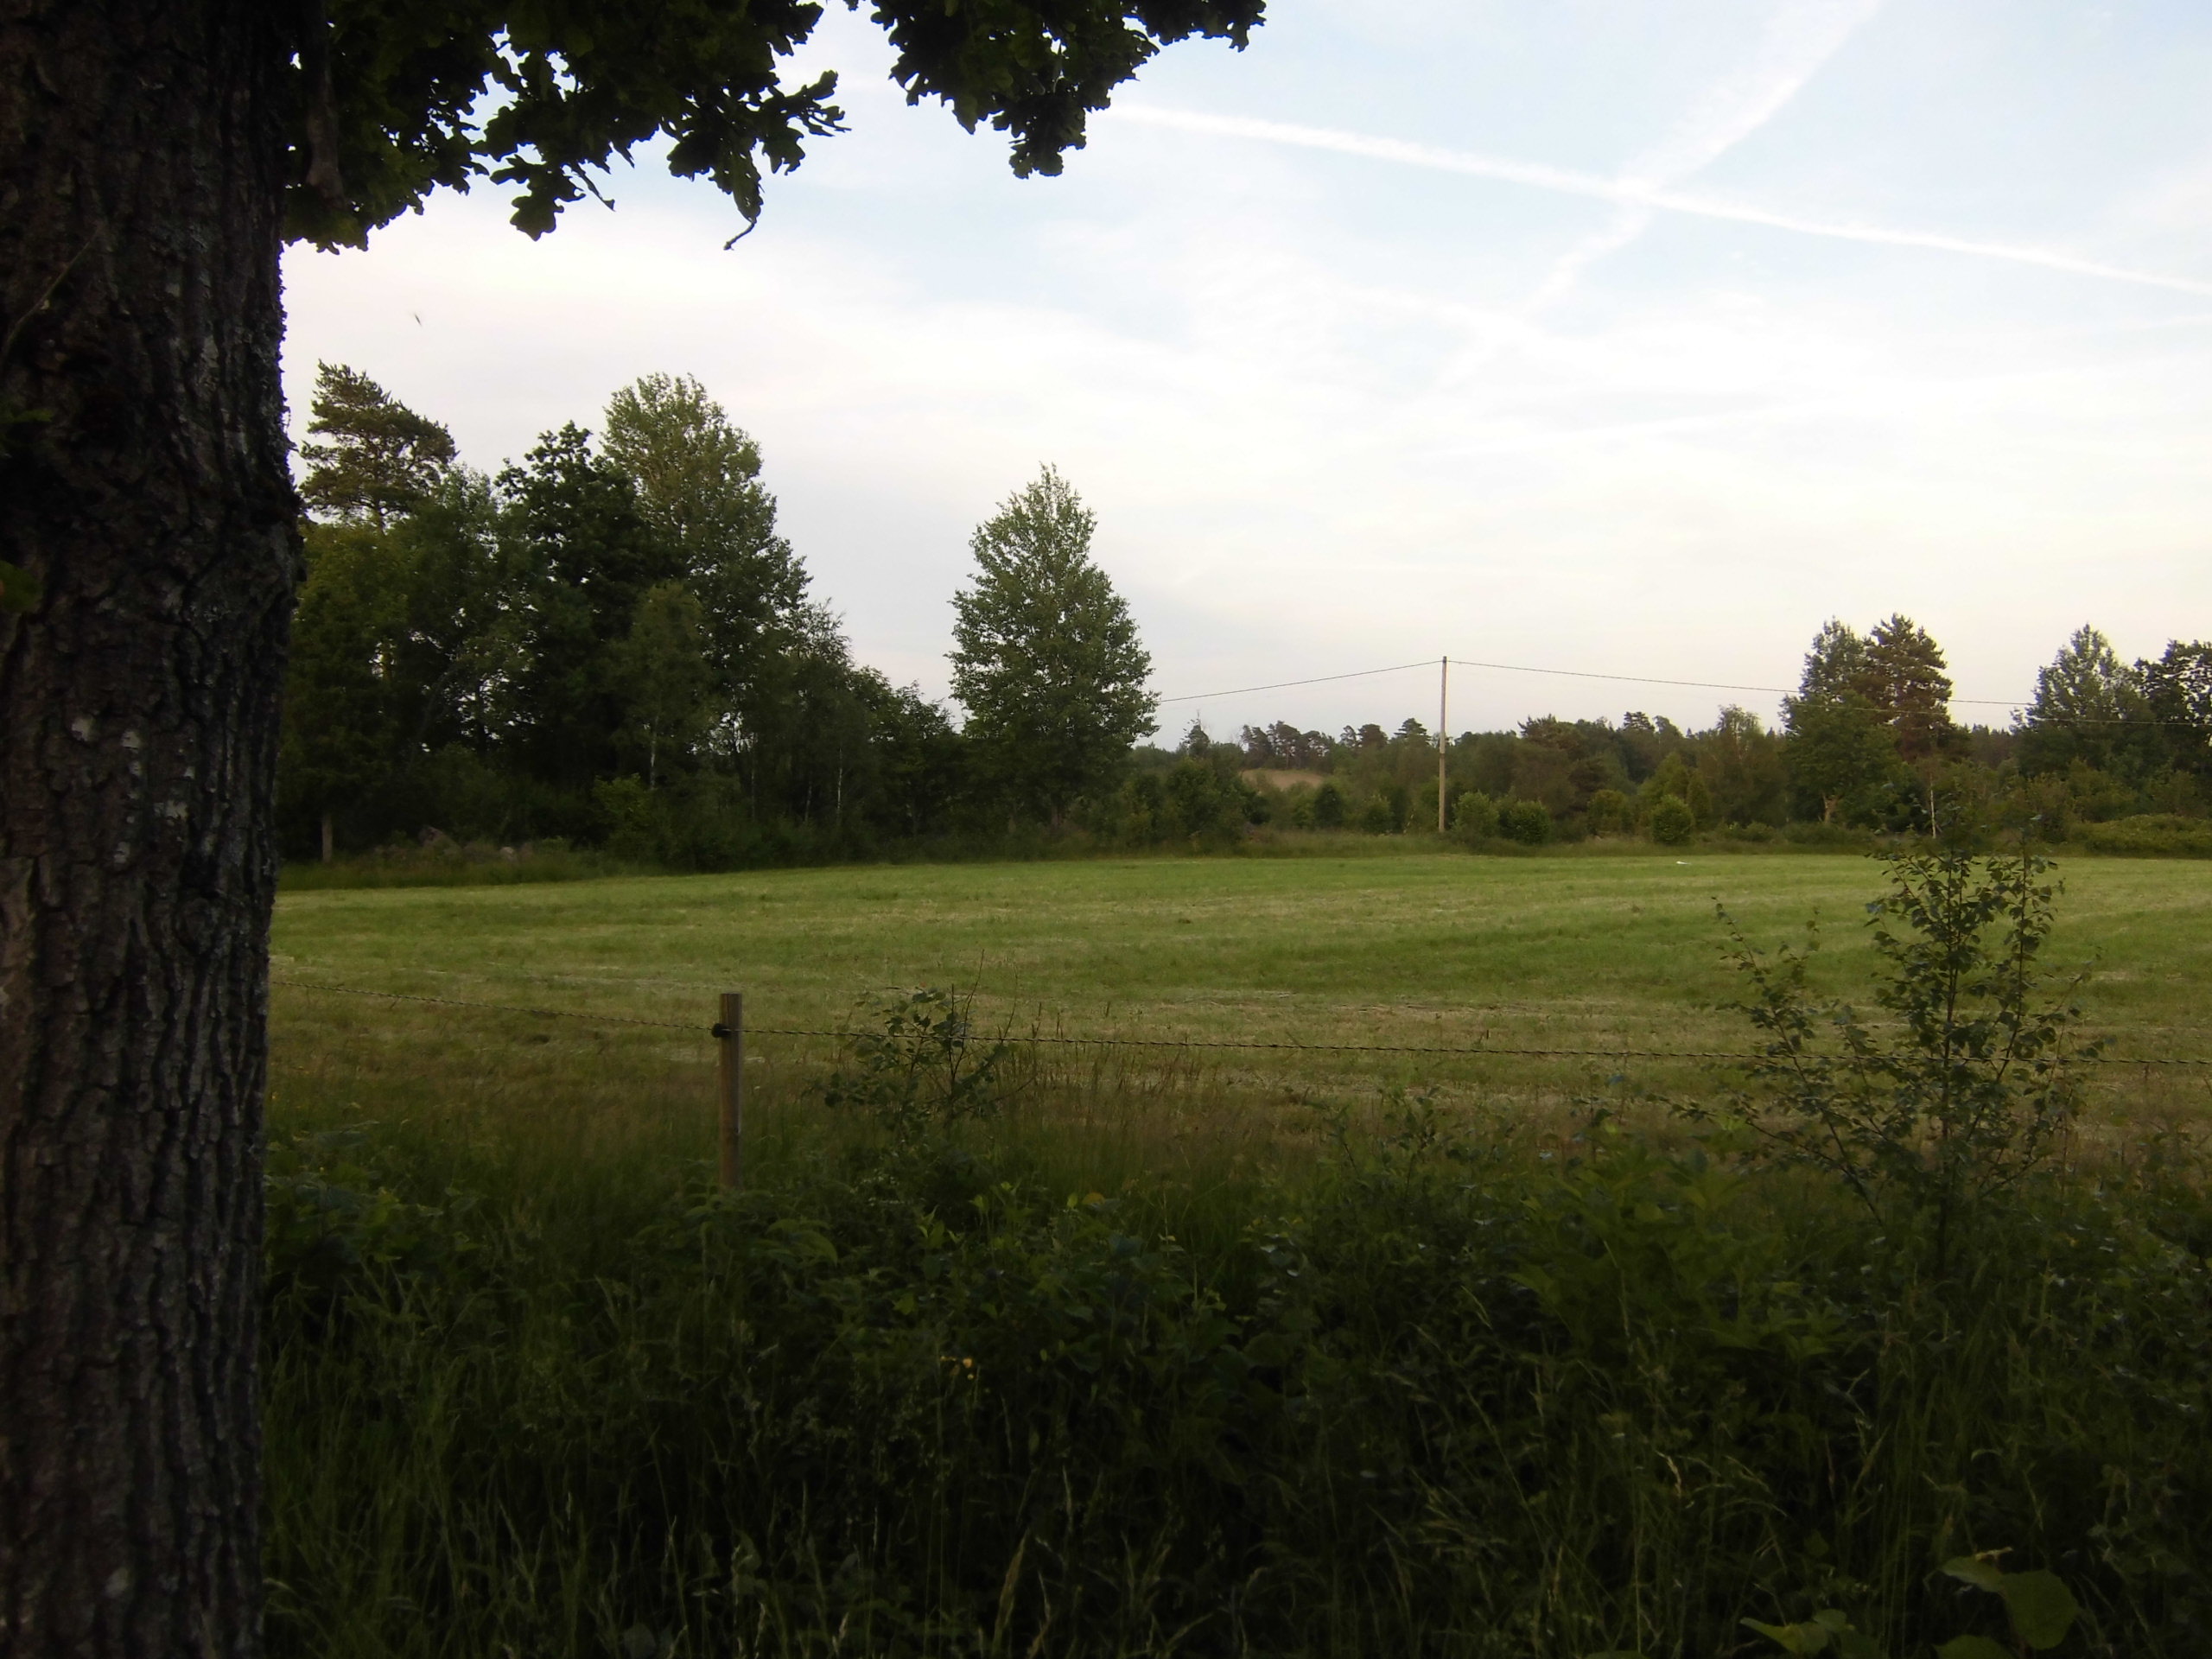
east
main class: Woodland
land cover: Broadleaved woodland
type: hemiboreal forest and nemoral coniferous forest and mixed broadleaved-coniferous forest
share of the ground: 50 - 75 %
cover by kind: broadleaved forest trees 50 %, herbaceous plants 30 %, shrubs 10 %, coniferous forest trees 5 %, lichens and mosses 5 %
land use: Forestry
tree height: > 5 m
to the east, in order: Broadleaved woodland; Fences; Grassland with sparse tree/shrub cover; Broadleaved woodland; Dry stone walls; Fences; Grassland with sparse tree/shrub cover; Electric lines; Grassland with sparse tree/shrub cover; Broadleaved woodland; Grassland without tree/shrub cover; Fences; Grass margins; Tracks; Grass margins; Single bushes/trees; Grassland with sparse tree/shrub cover
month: July
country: SE
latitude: 57.2861
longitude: 14.8241
